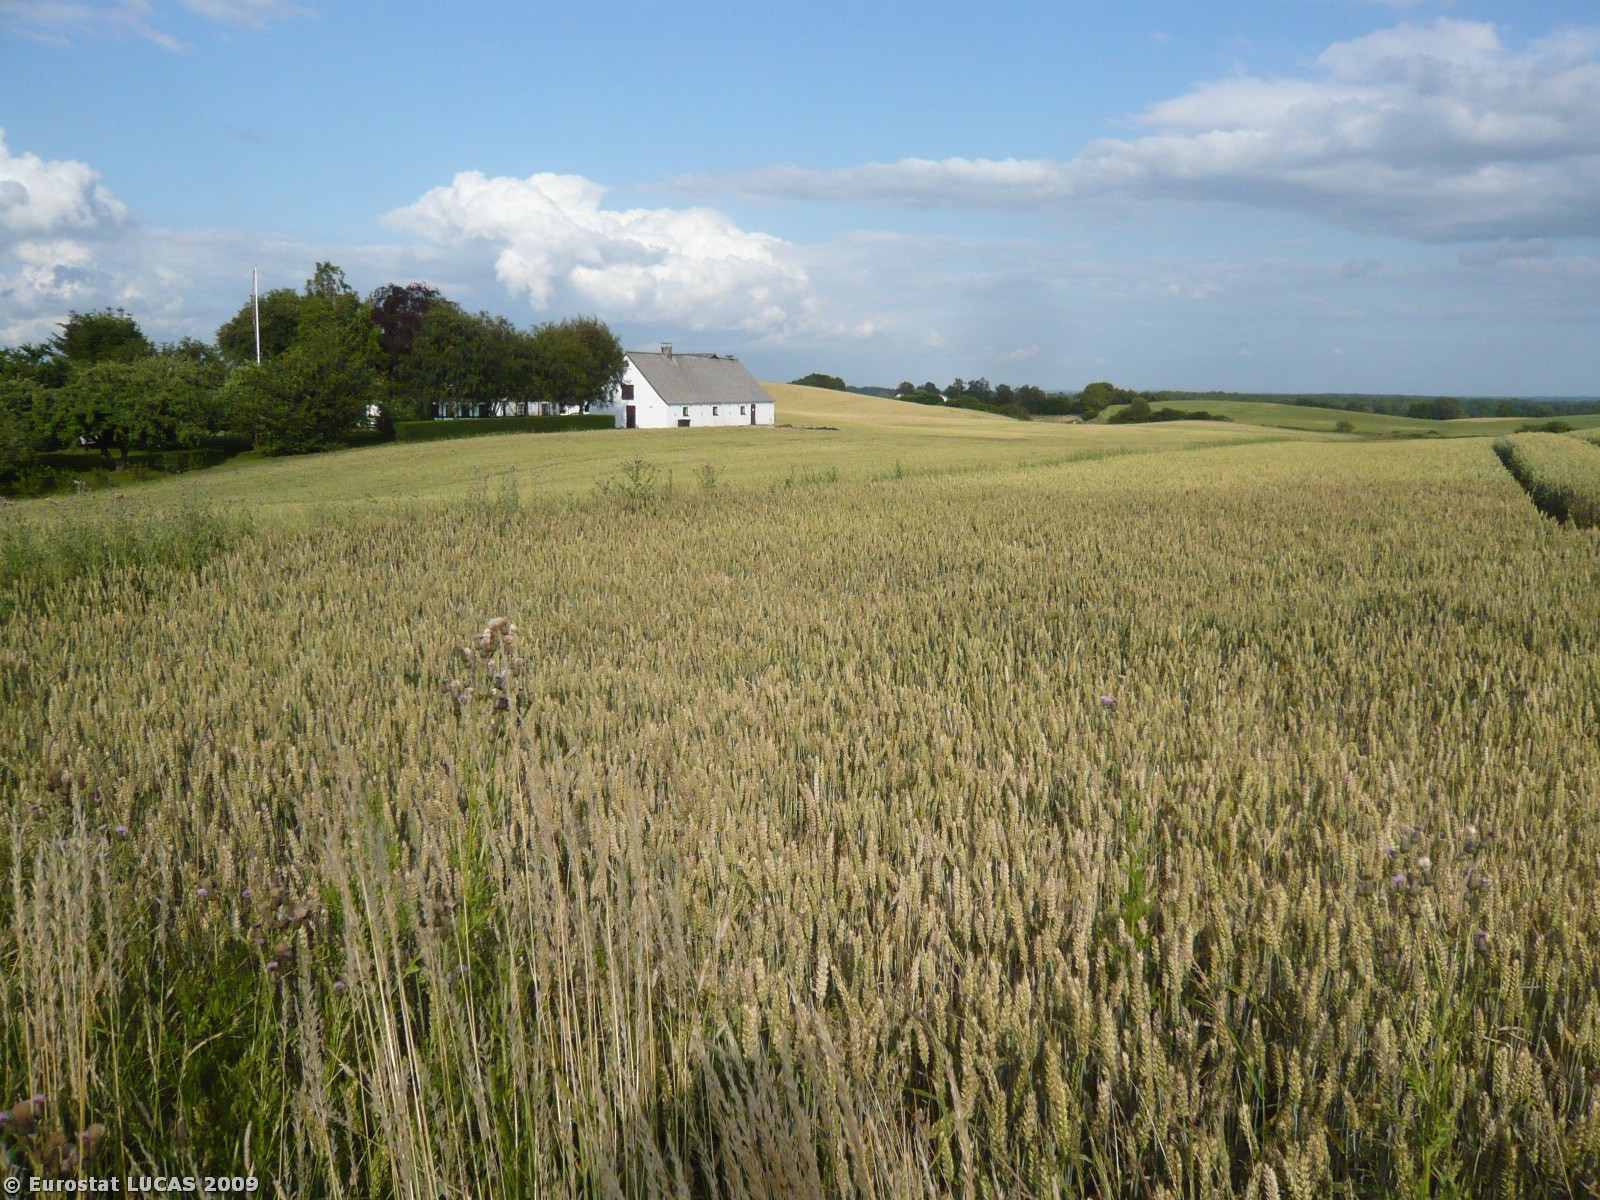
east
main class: Cropland
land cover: Common wheat
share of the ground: > 75 %
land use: Agriculture (excluding fallow land and kitchen gardens)
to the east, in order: Common wheat; Glaciers, permanent snow; Common wheat
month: July
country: DK
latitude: 55.6036
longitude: 11.5065
